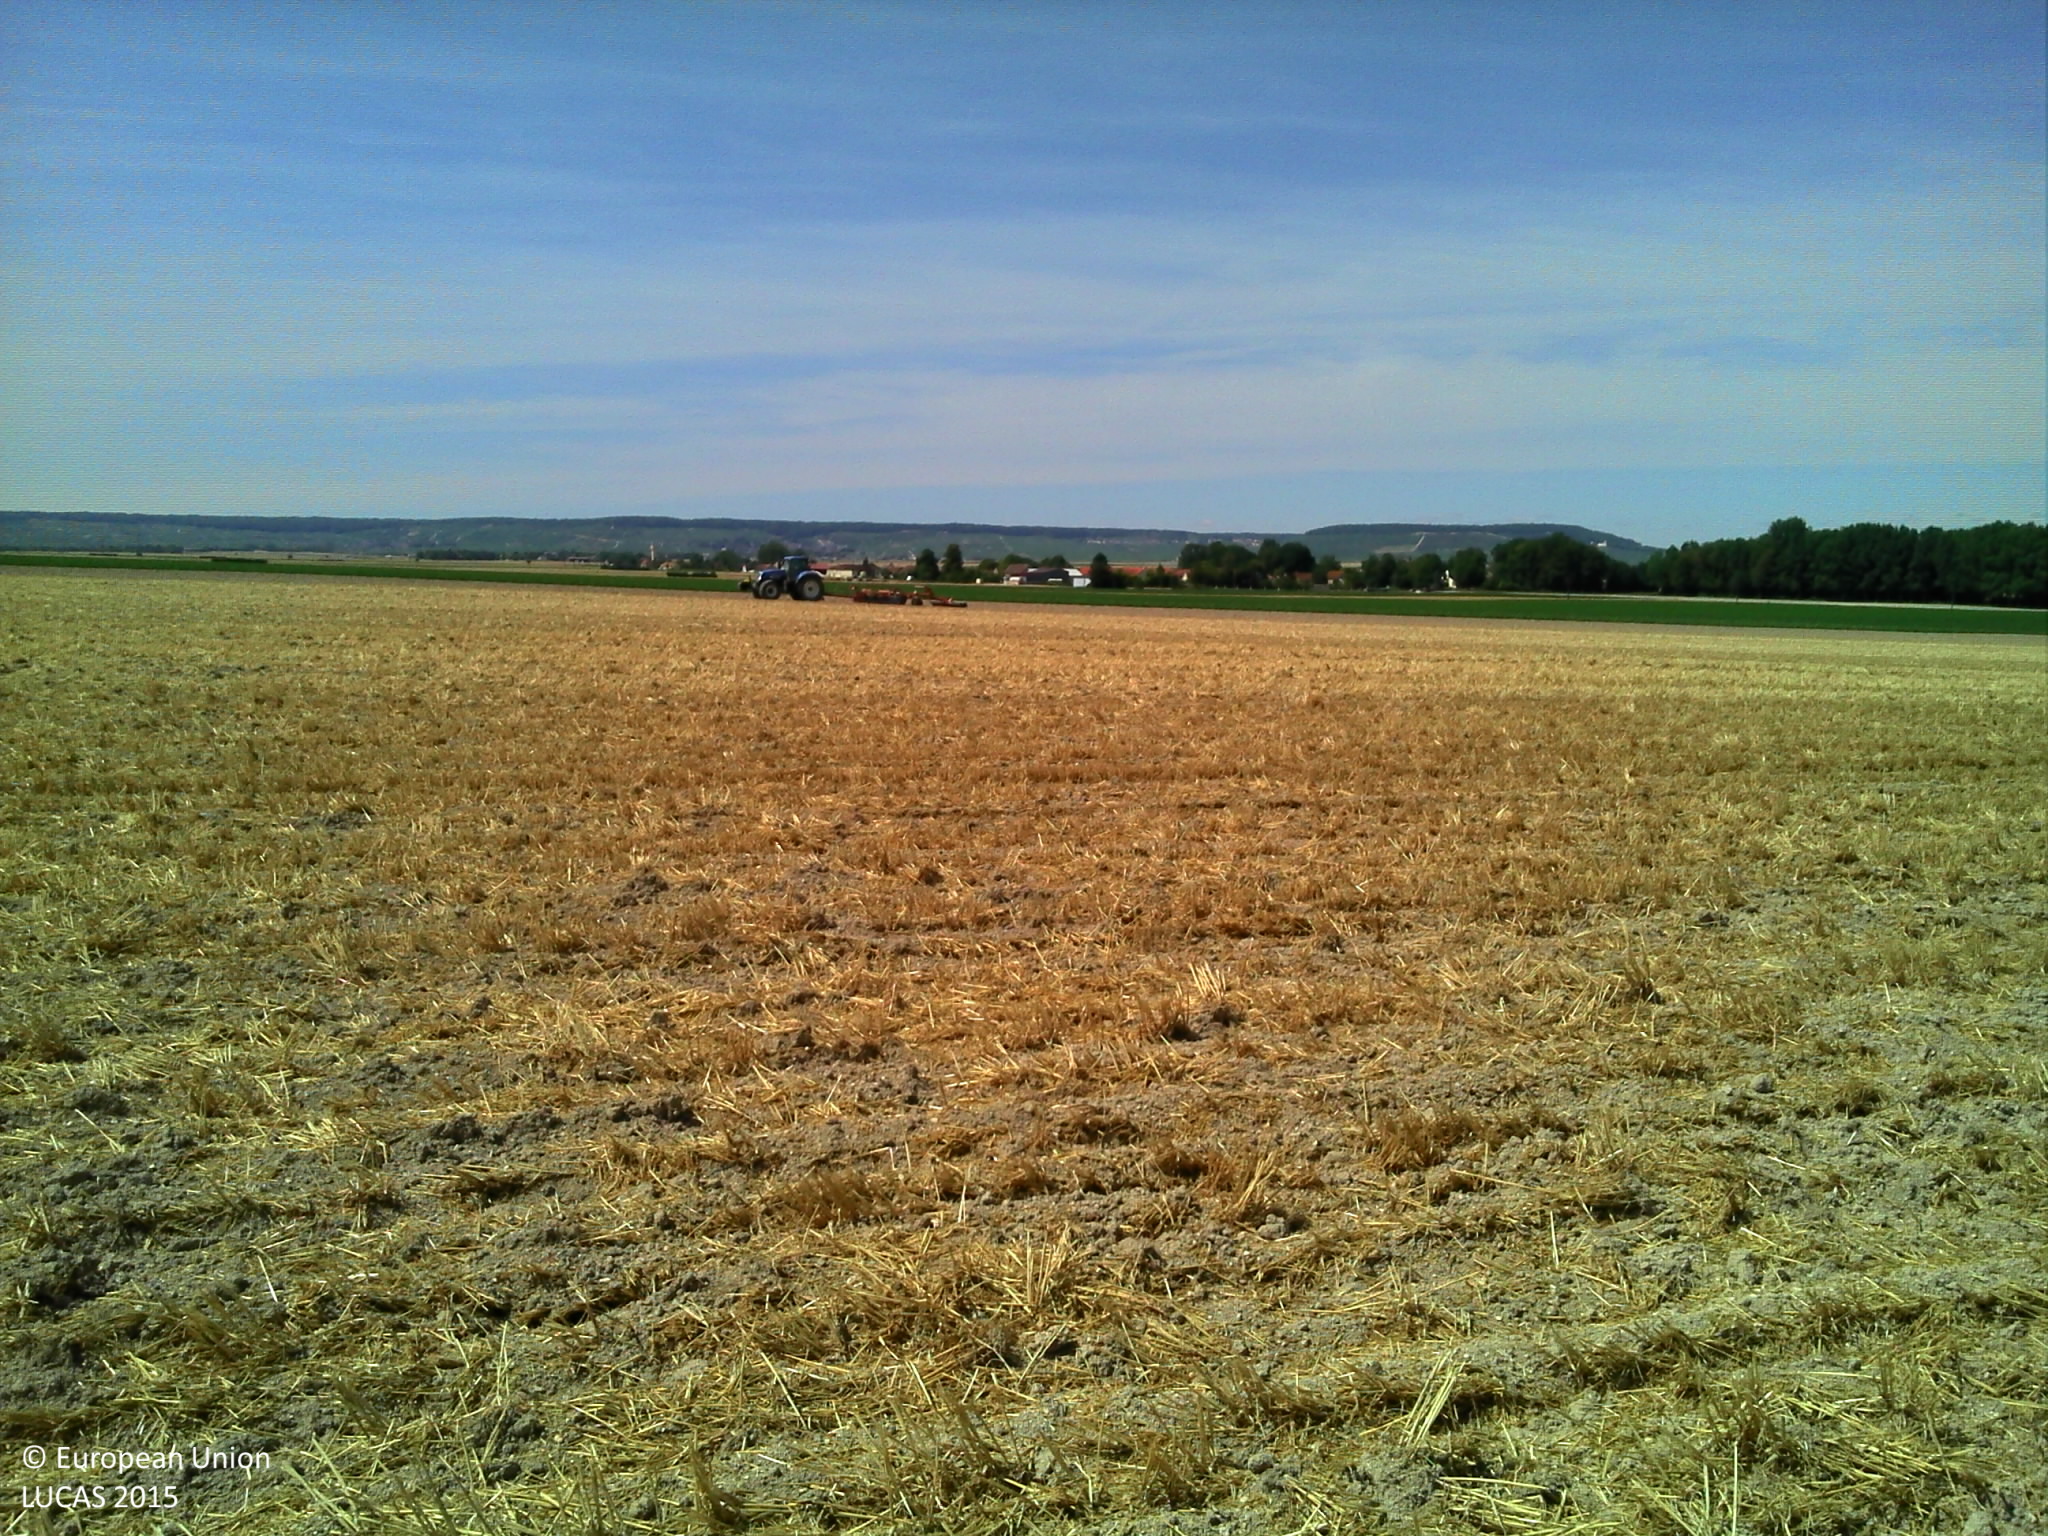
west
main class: Cropland
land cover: Common wheat
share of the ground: > 75 %
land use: Agriculture (excluding fallow land and kitchen gardens)
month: August
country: FR
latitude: 48.9859
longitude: 4.1059
